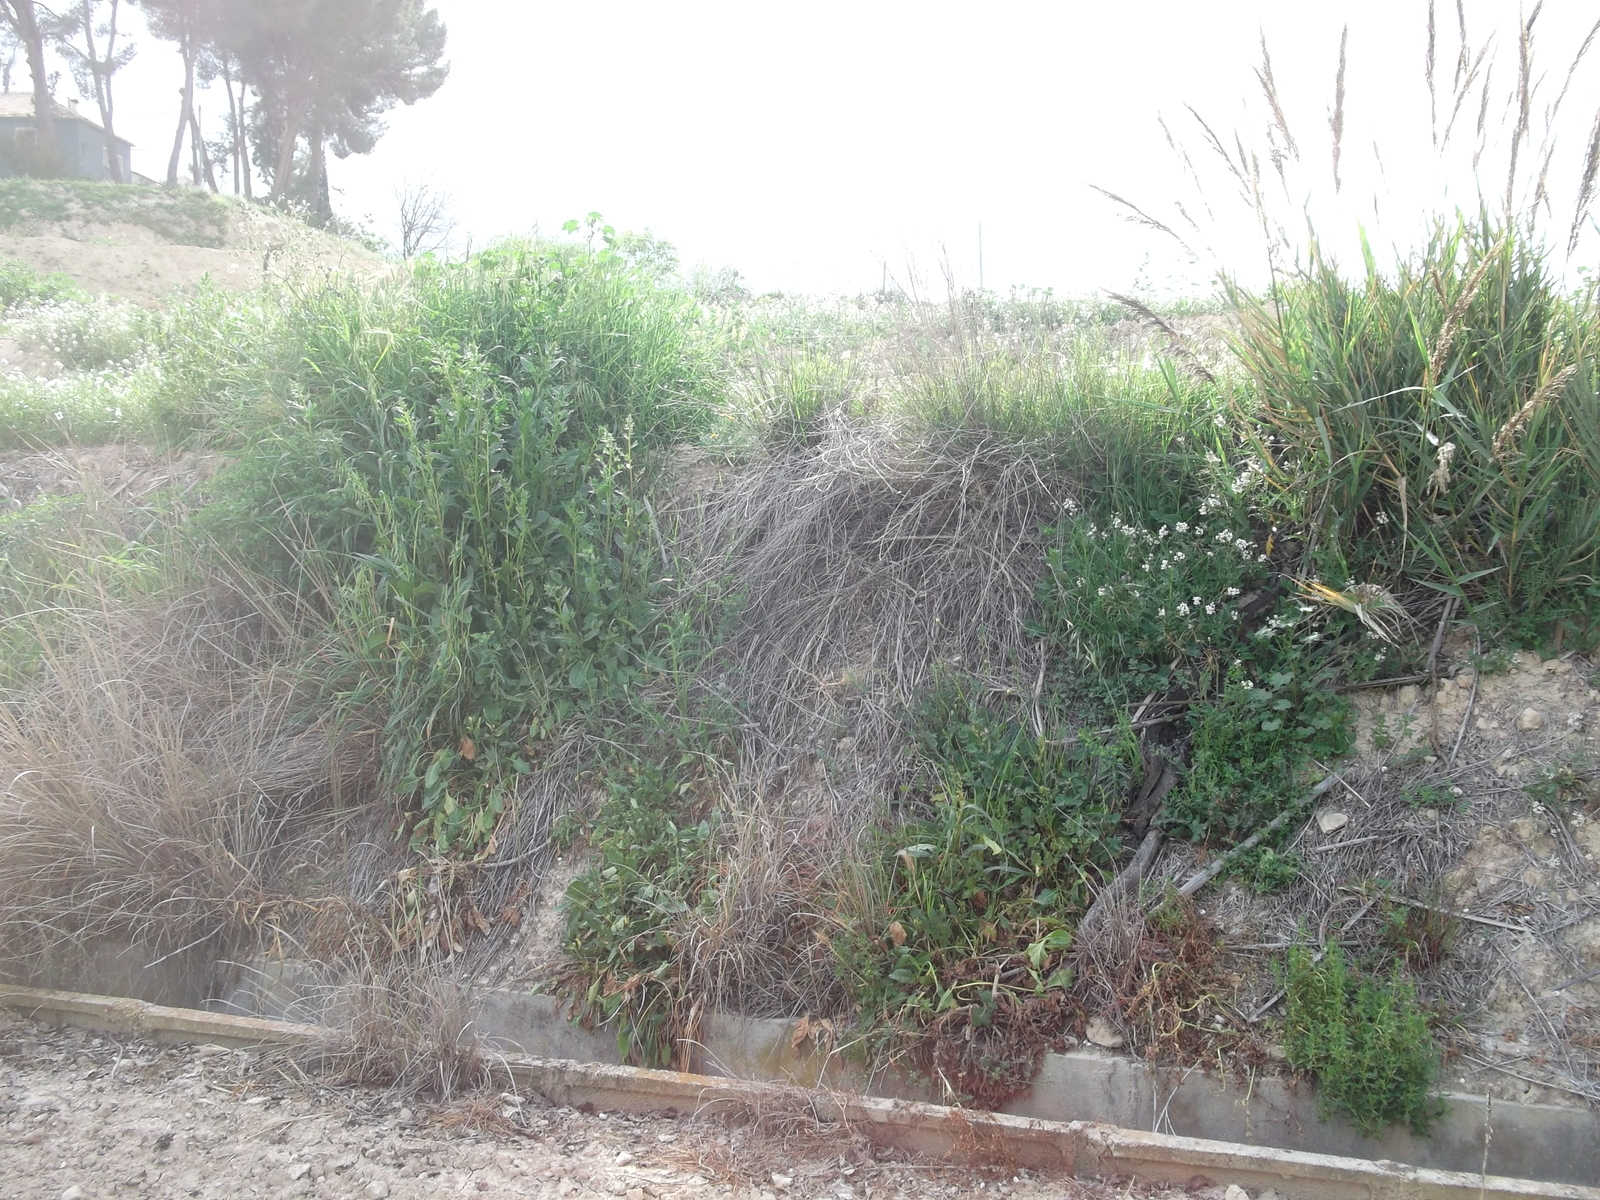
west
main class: Cropland
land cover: Other fruit trees and berries
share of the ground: 10 - 25 %
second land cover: Other bare soil
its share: > 75 %
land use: Agriculture (excluding fallow land and kitchen gardens)
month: April
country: ES
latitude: 38.0321
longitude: -1.5274
